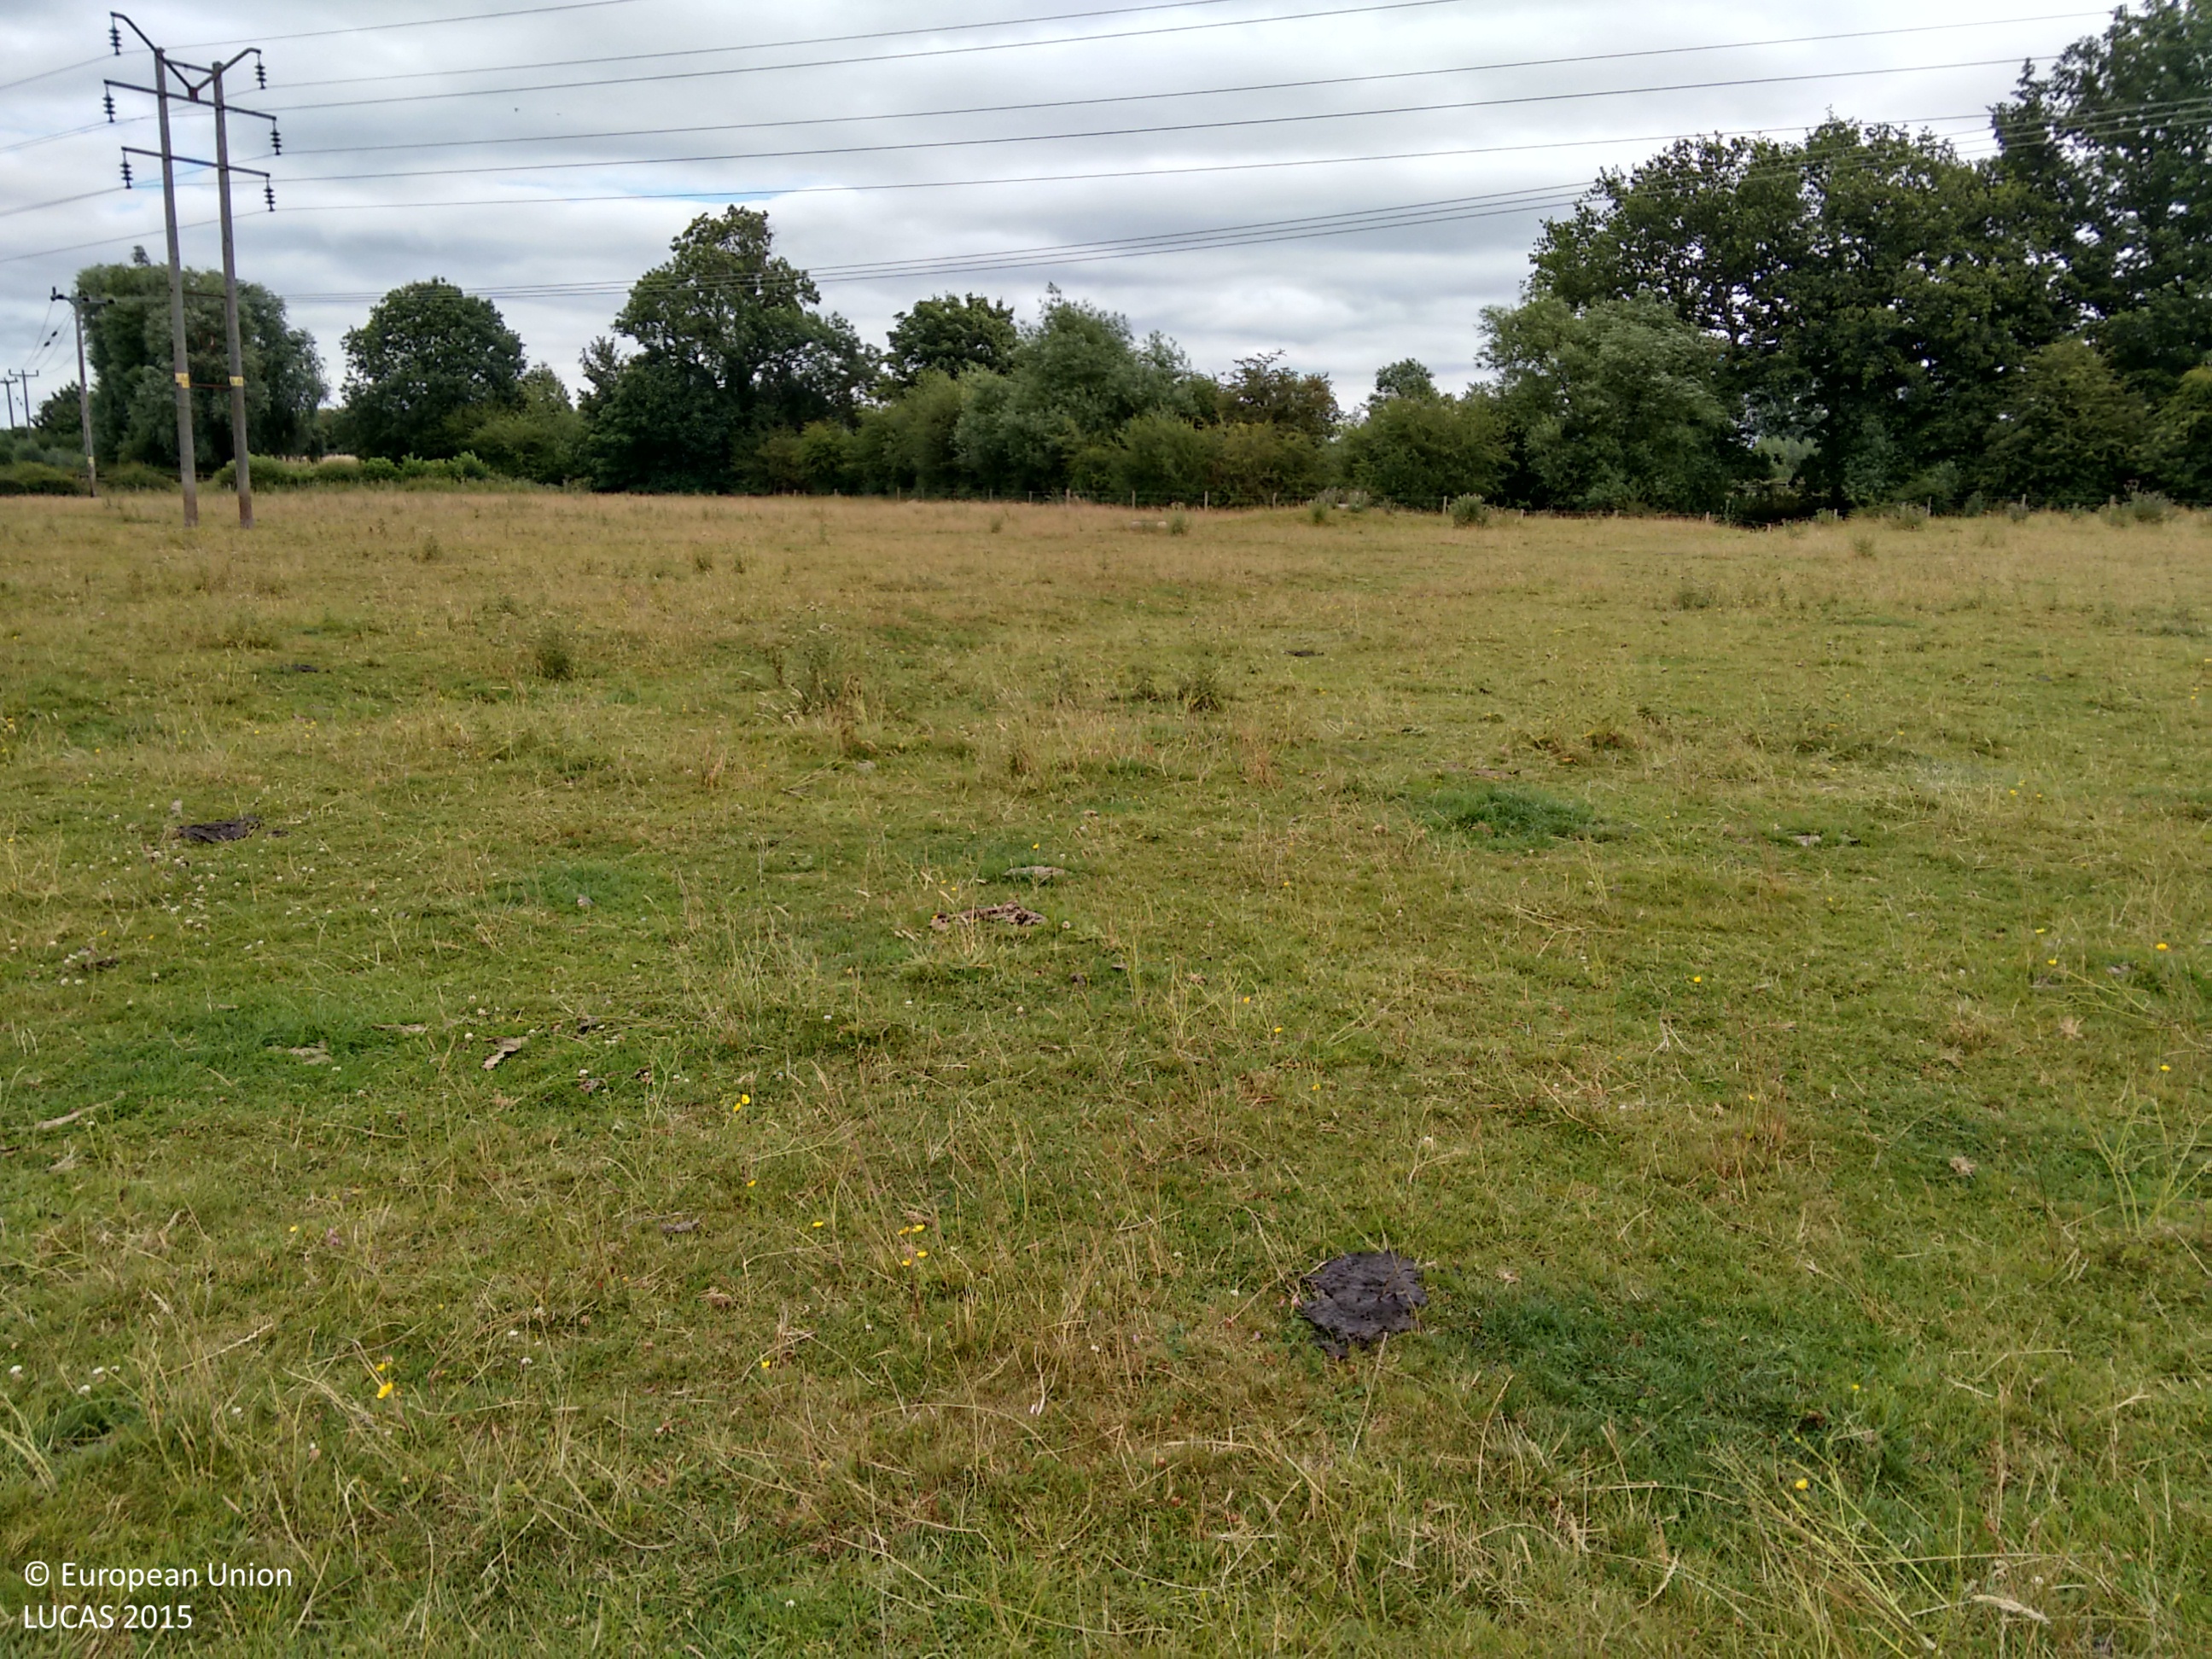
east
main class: Grassland
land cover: Grassland without tree/shrub cover
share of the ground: > 75 %
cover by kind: herbaceous plants 100 %
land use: Agriculture (excluding fallow land and kitchen gardens)
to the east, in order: Grassland without tree/shrub cover; Electric lines; Grassland without tree/shrub cover; Electric lines; Grassland without tree/shrub cover; Fences; Grassland without tree/shrub cover; Rivers and streams; Broadleaved woodland; Fences; Grassland without tree/shrub cover; Fences; Managed hedges; Grass margins; Ditches and canals; Abandoned hedges; Grass margins; Paved roads, cycling and walking lanes; Grass margins; Ditches and canals; Broadleaved woodland; Fences; Grassland without tree/shrub cover
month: July
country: GB
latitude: 52.4912
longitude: -0.8973
